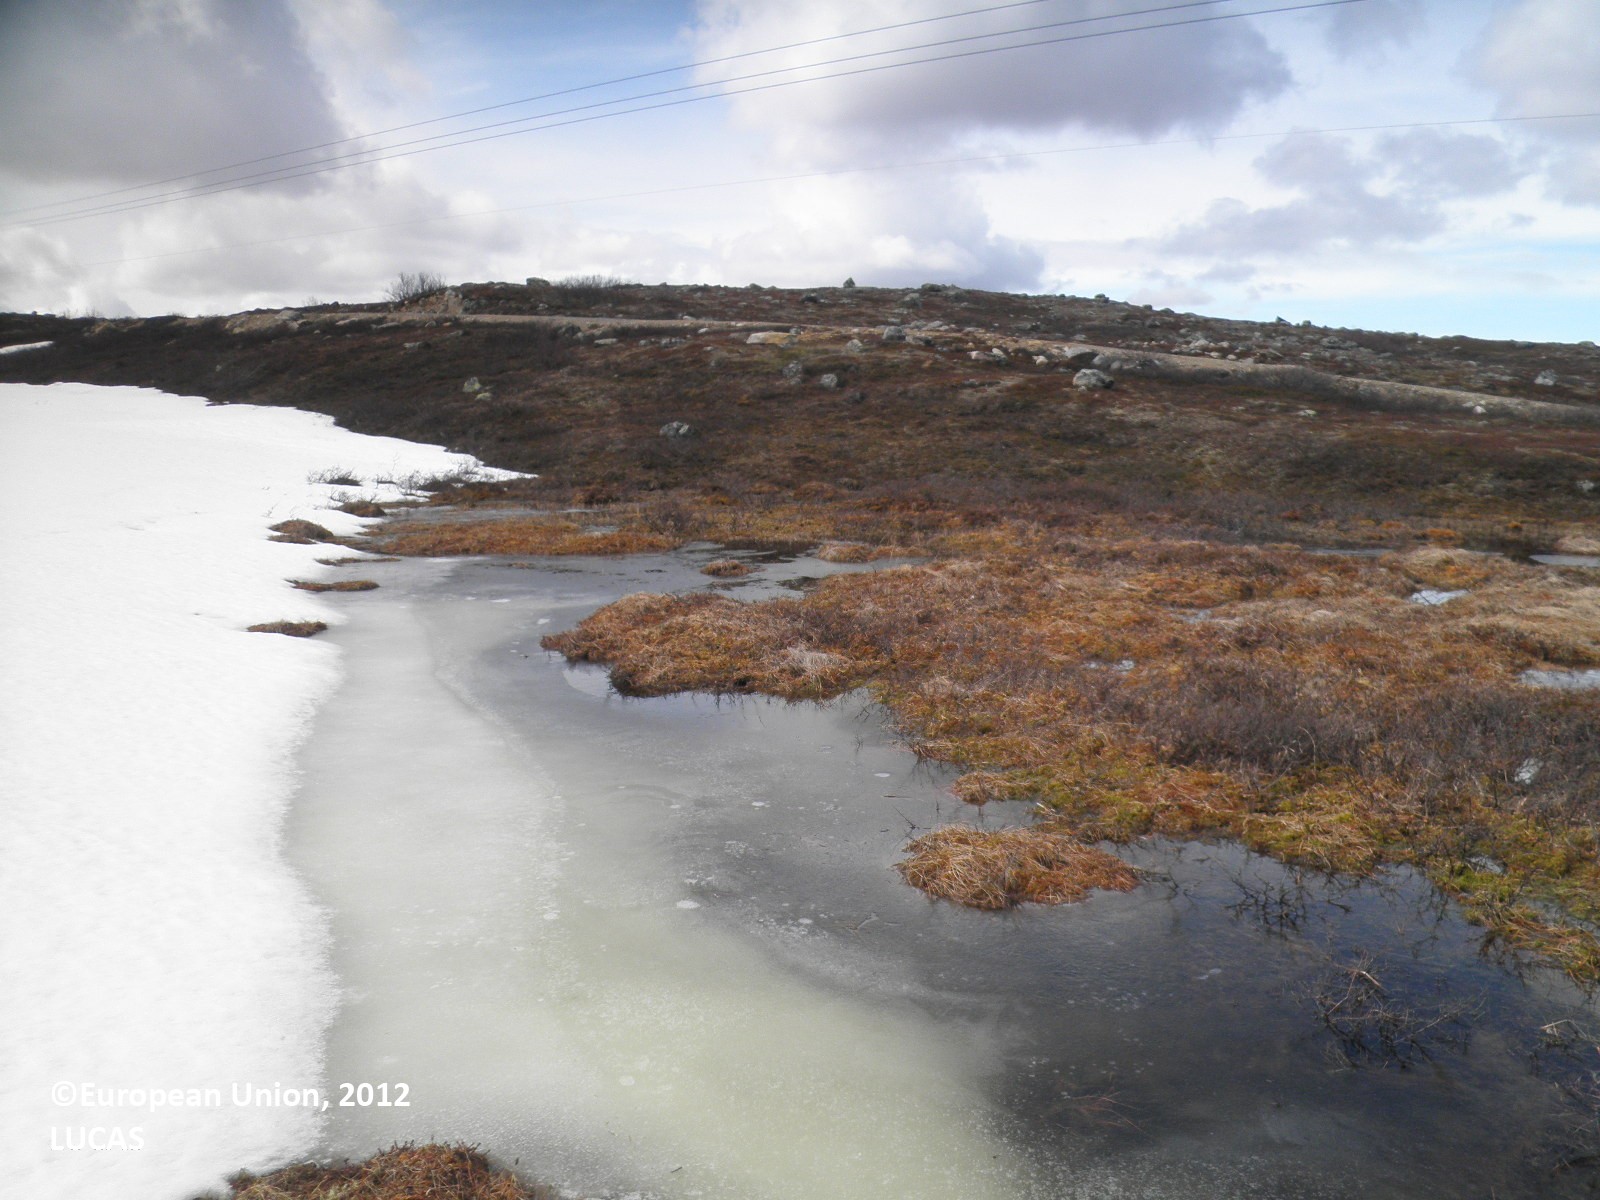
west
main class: Shrubland
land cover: Shrubland without tree cover
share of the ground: > 75 %
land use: Semi-natural and natural areas not in use
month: May
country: FI
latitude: 69.8993
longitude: 27.0673
